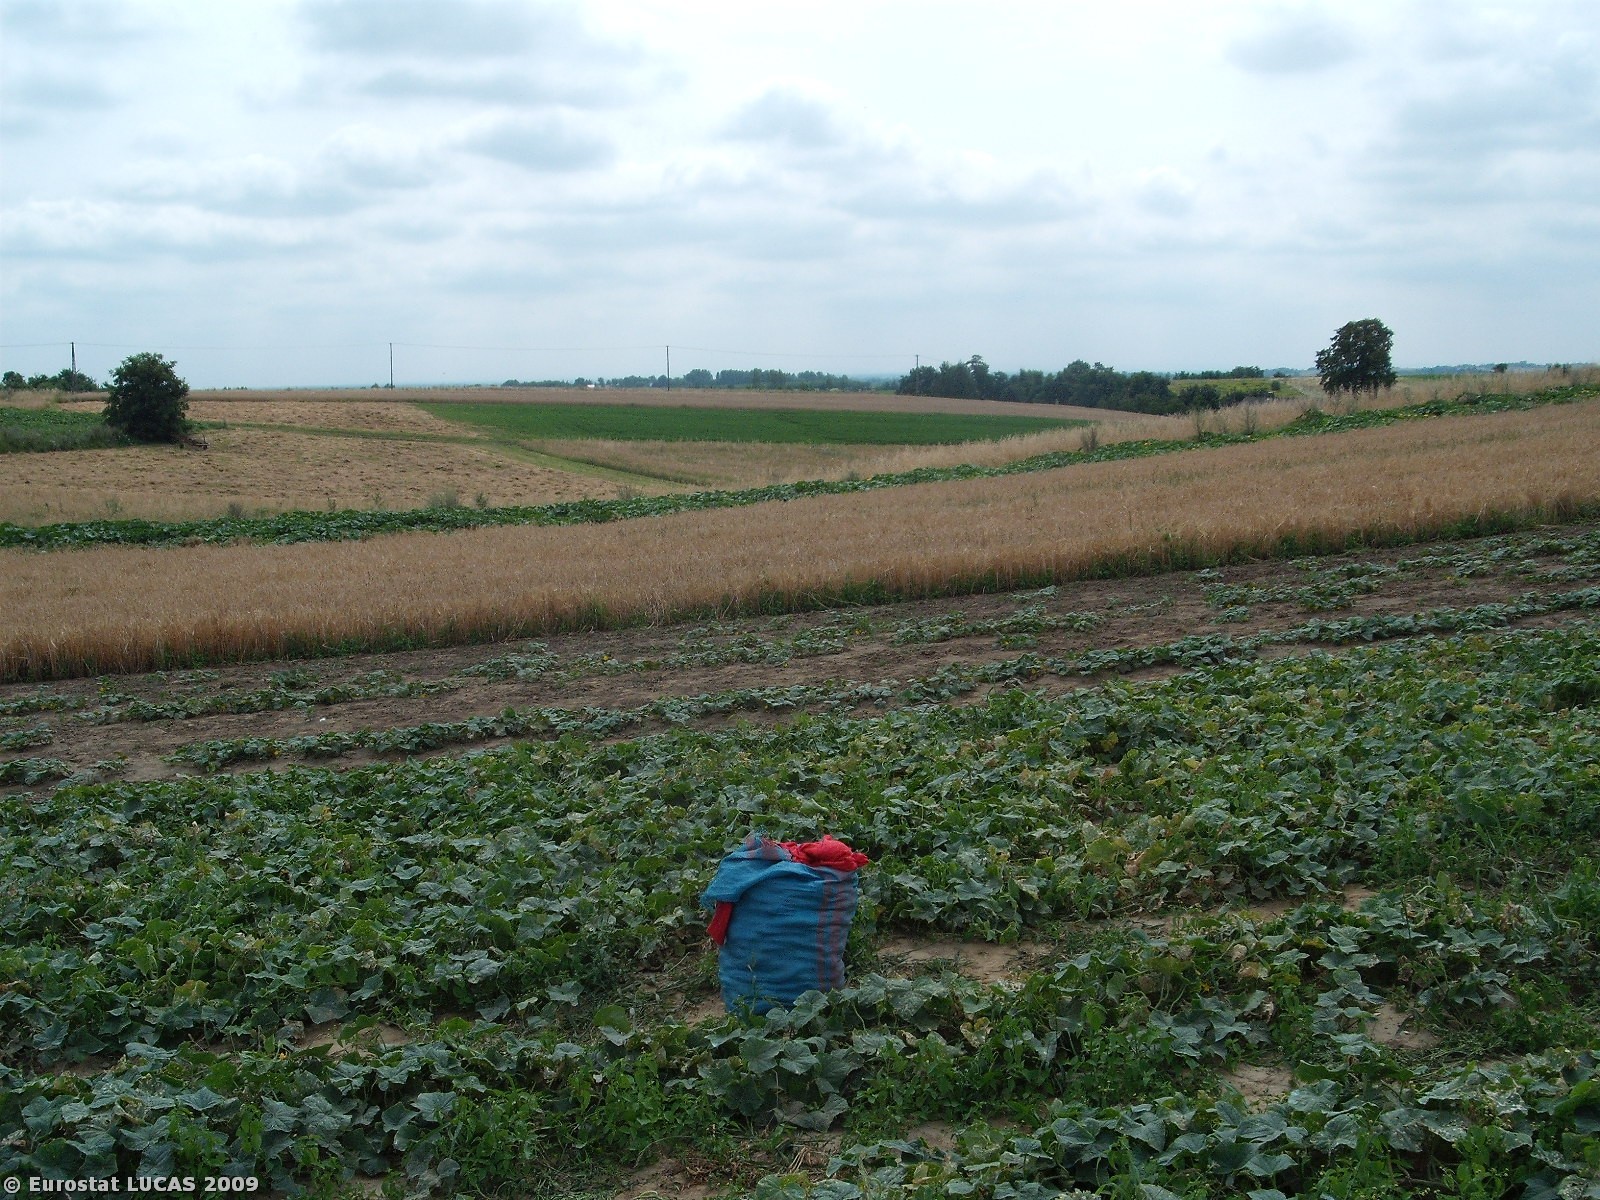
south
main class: Cropland
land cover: Other fresh vegetables
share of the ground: > 75 %
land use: Agriculture (excluding fallow land and kitchen gardens)
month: August
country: PL
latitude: 50.2280
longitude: 20.6510
